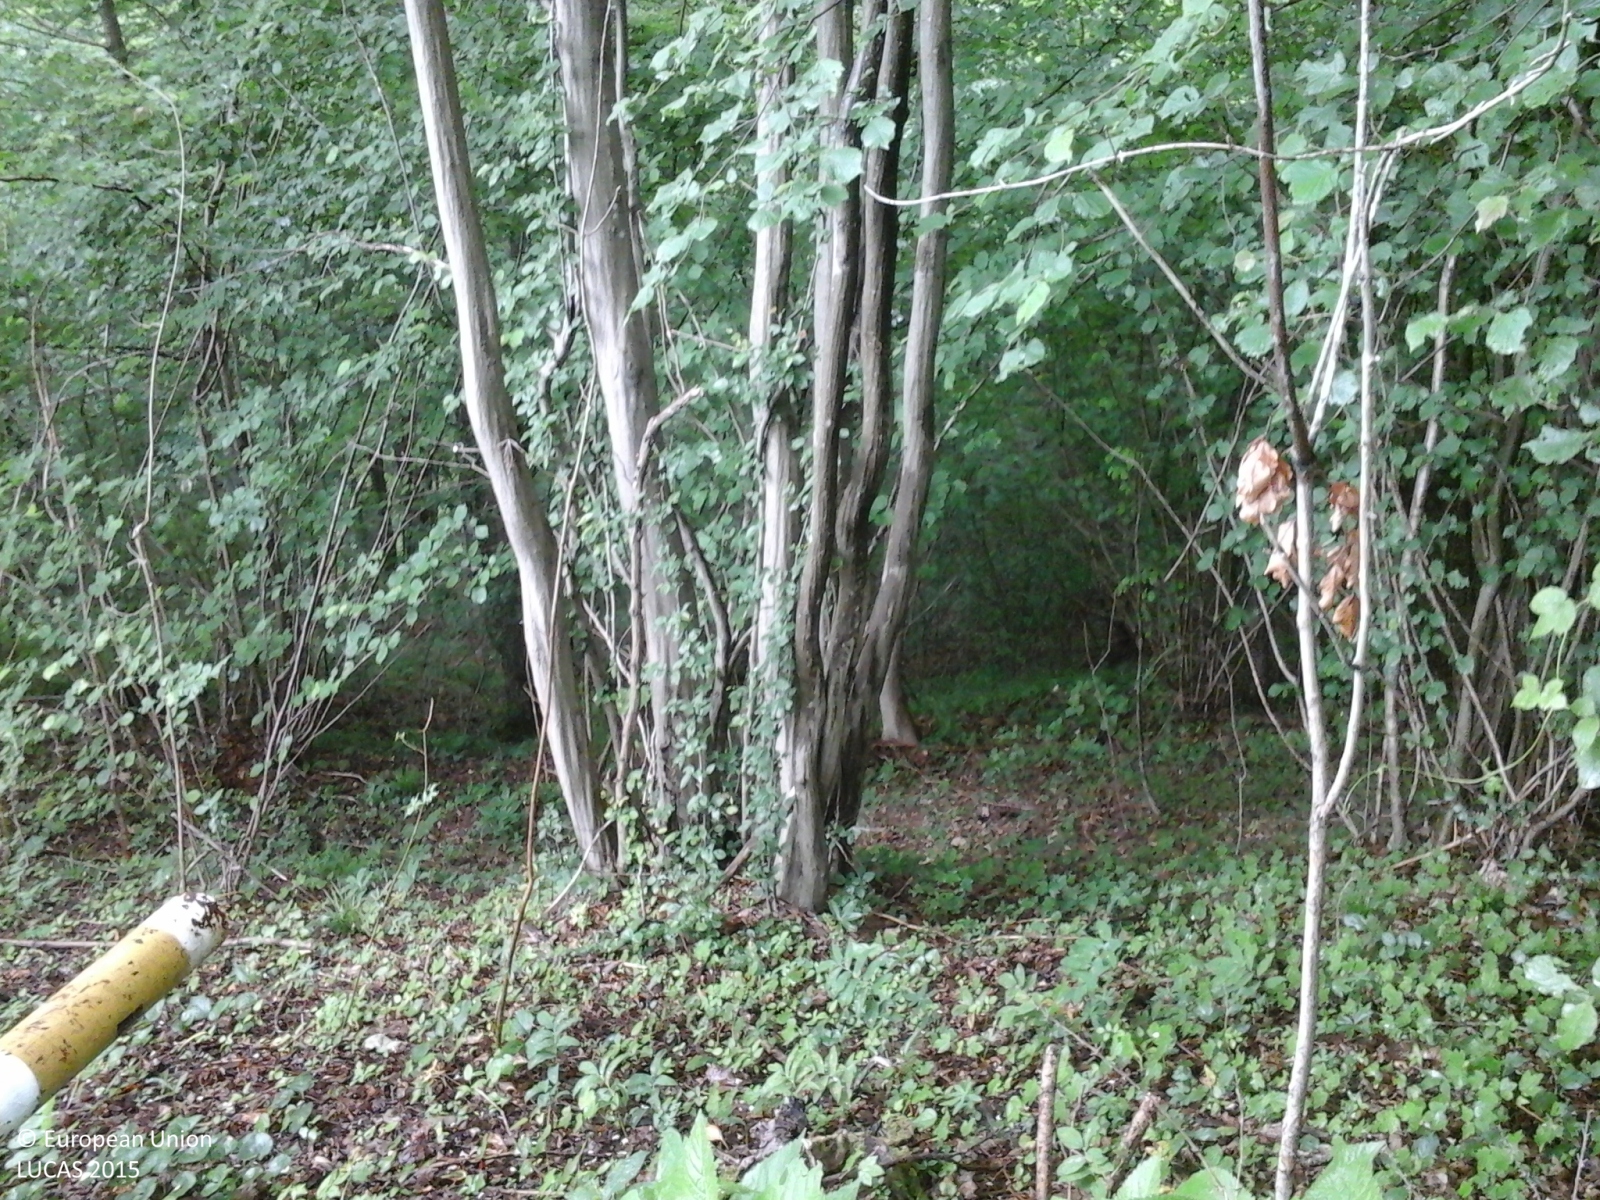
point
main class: Woodland
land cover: Broadleaved woodland
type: thermophilous deciduous forest
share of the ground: > 75 %
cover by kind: broadleaved forest trees 100 %
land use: Semi-natural and natural areas not in use
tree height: > 5 m
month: June
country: IT
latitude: 46.1268
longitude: 12.3654
